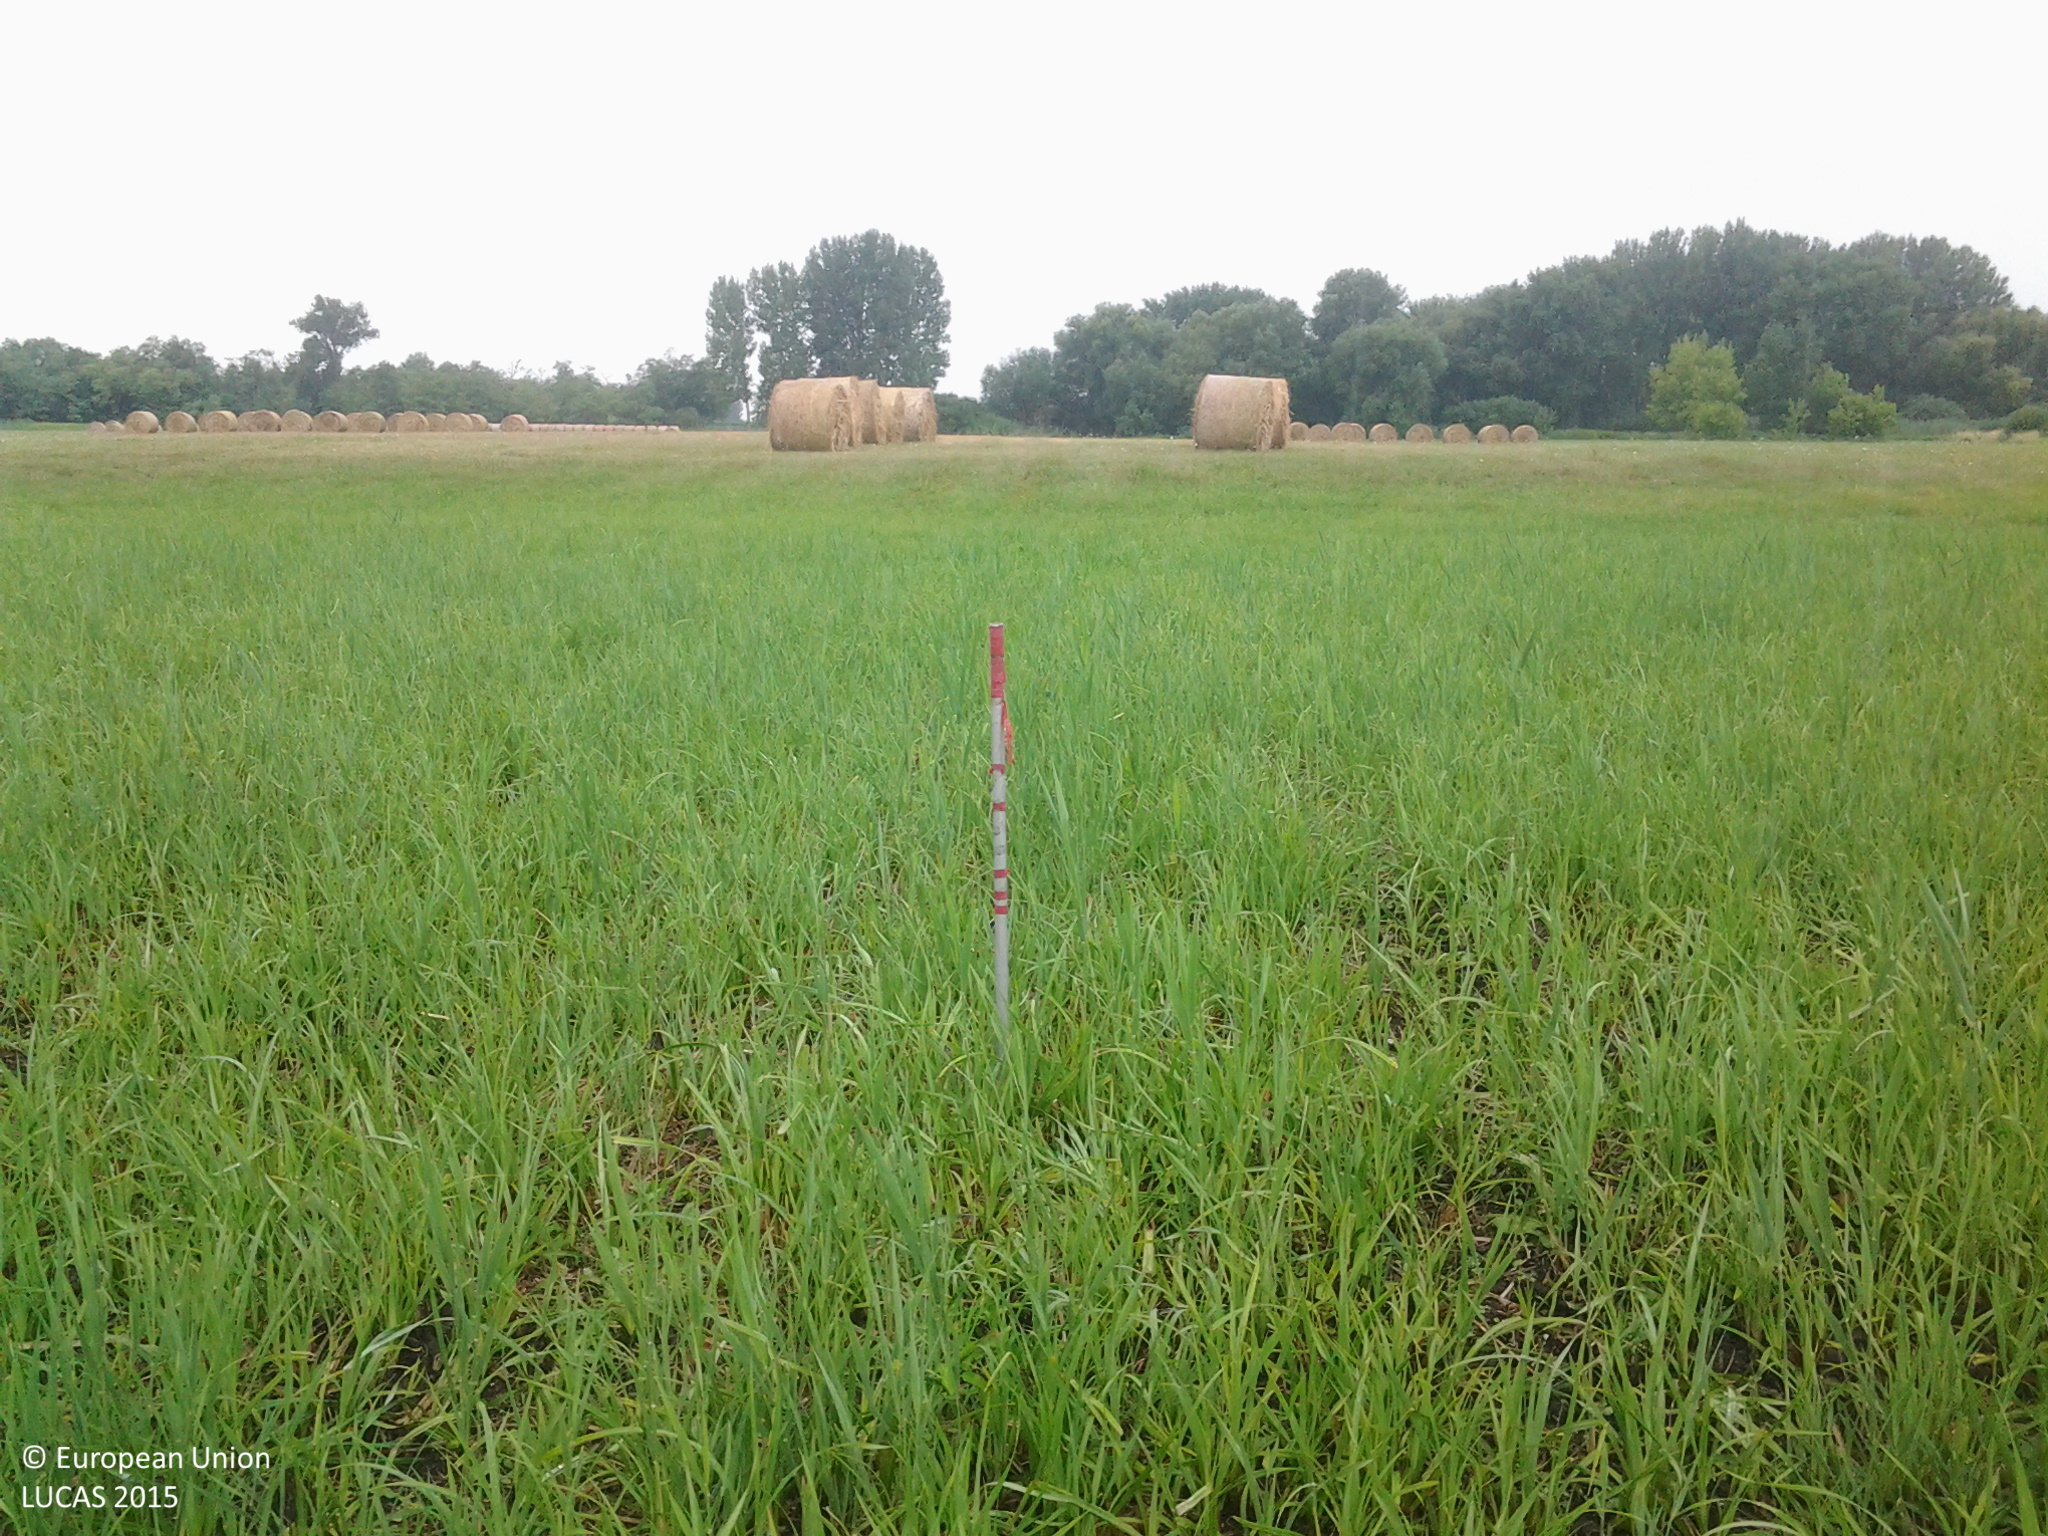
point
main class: Grassland
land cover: Grassland without tree/shrub cover
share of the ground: > 75 %
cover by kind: herbaceous plants 100 %
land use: Agriculture (excluding fallow land and kitchen gardens)
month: July
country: HU
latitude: 46.6738
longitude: 19.2581
